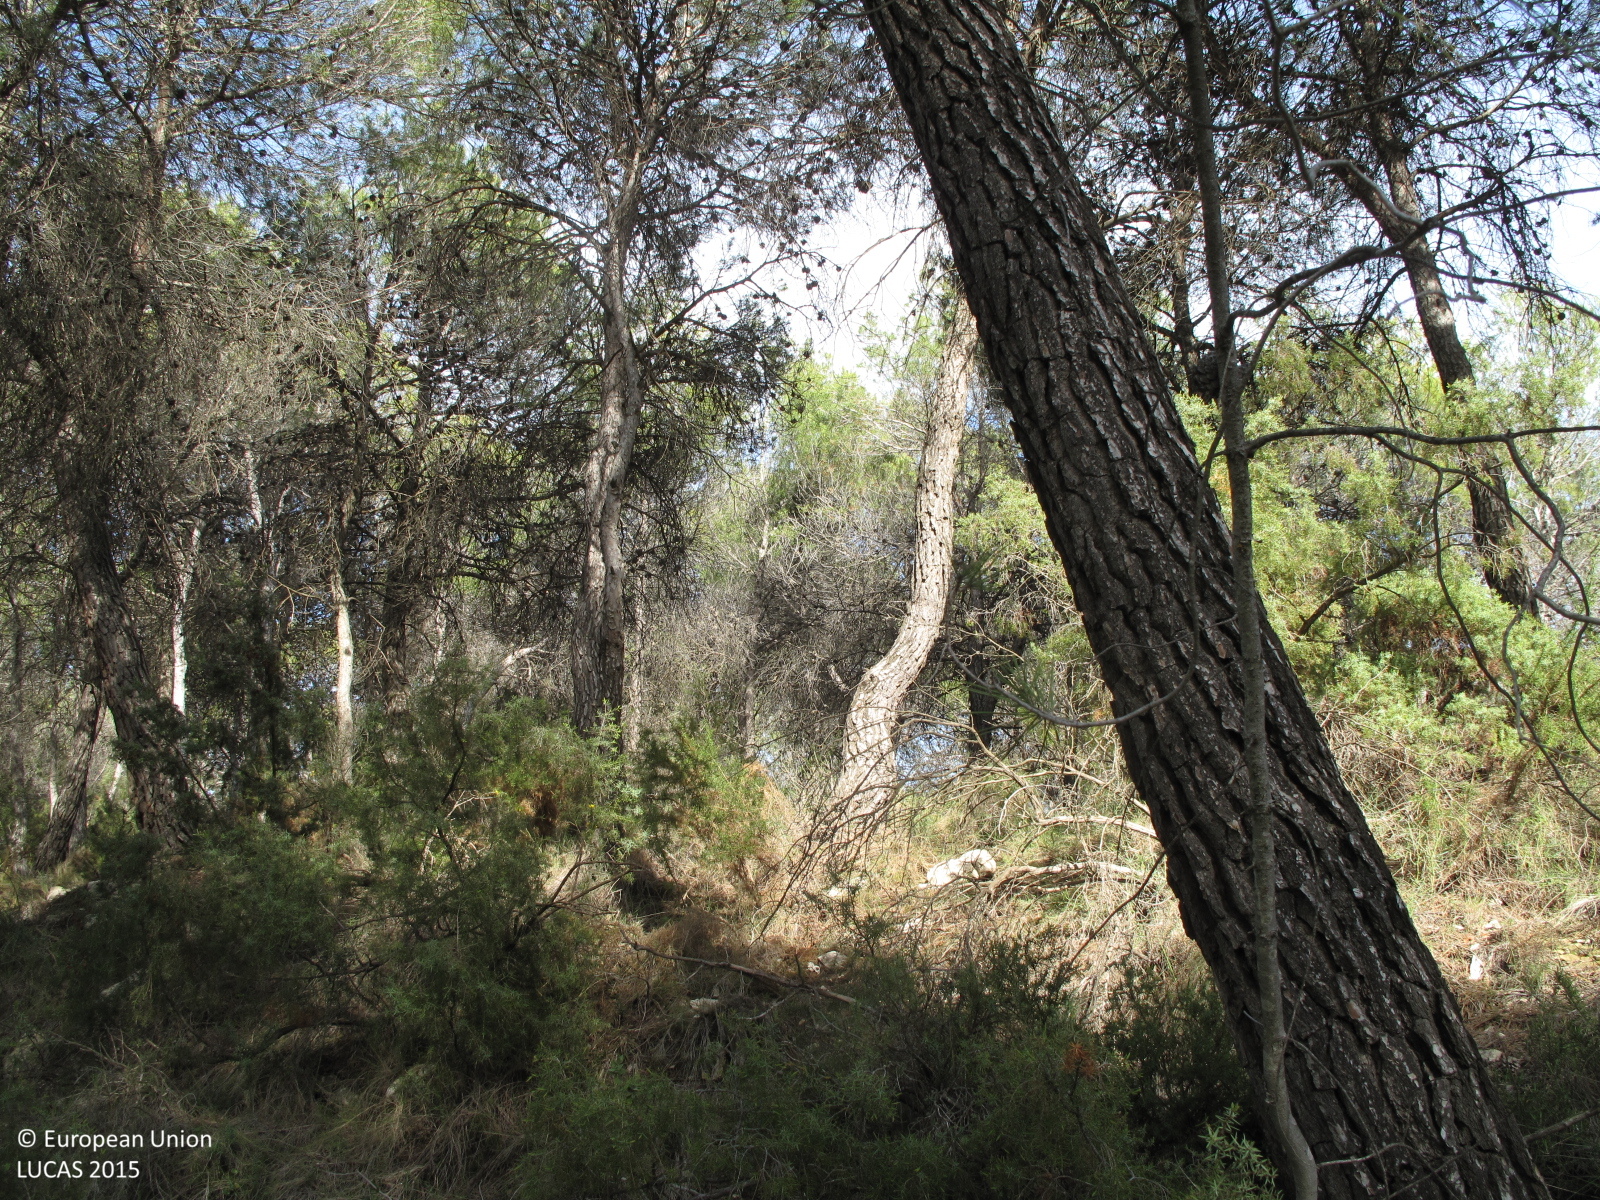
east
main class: Woodland
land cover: Pine dominated coniferous woodland
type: coniferous forest of the mediterranean region
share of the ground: > 75 %
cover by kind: coniferous forest trees 80 %, shrubs 10 %, herbaceous plants 10 %
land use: Semi-natural and natural areas not in use
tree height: > 5 m
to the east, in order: Pine dominated coniferous woodland; Barley; Shruby margins; Barley; Shrubland with sparse tree cover; Barley; Grass margins; Barley
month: March
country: ES
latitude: 38.7158
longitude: -0.5129
